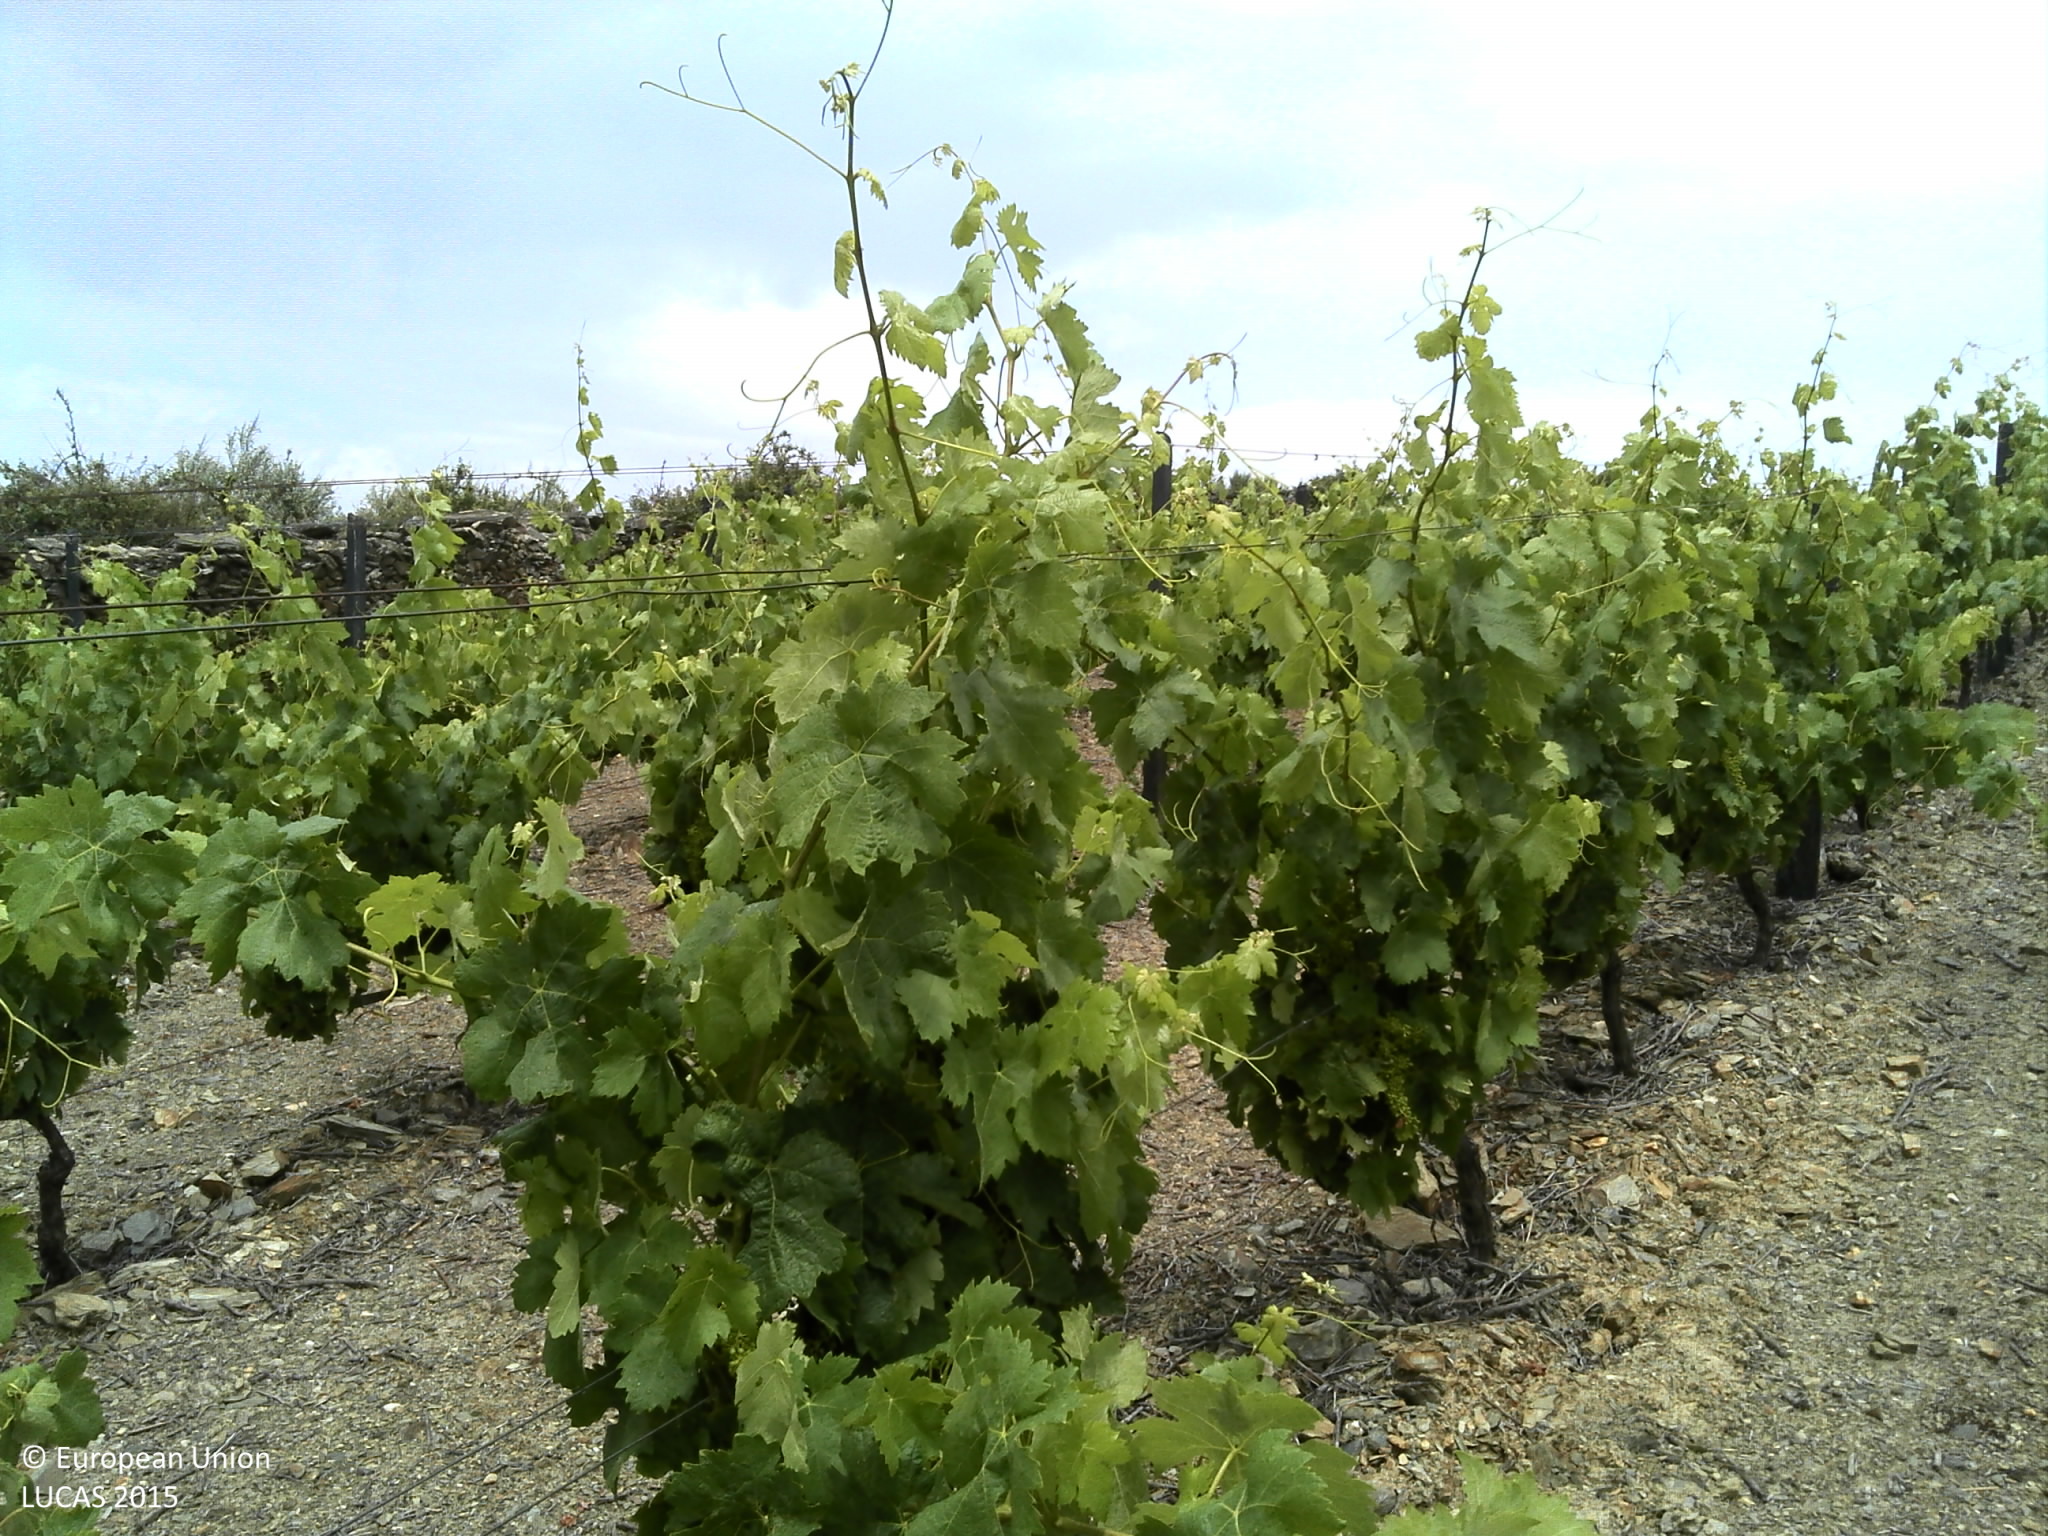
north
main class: Cropland
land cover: Vineyards
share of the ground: < 10 %
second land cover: Other bare soil
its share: > 75 %
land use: Agriculture (excluding fallow land and kitchen gardens)
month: June
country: PT
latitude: 41.1335
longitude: -7.4041
